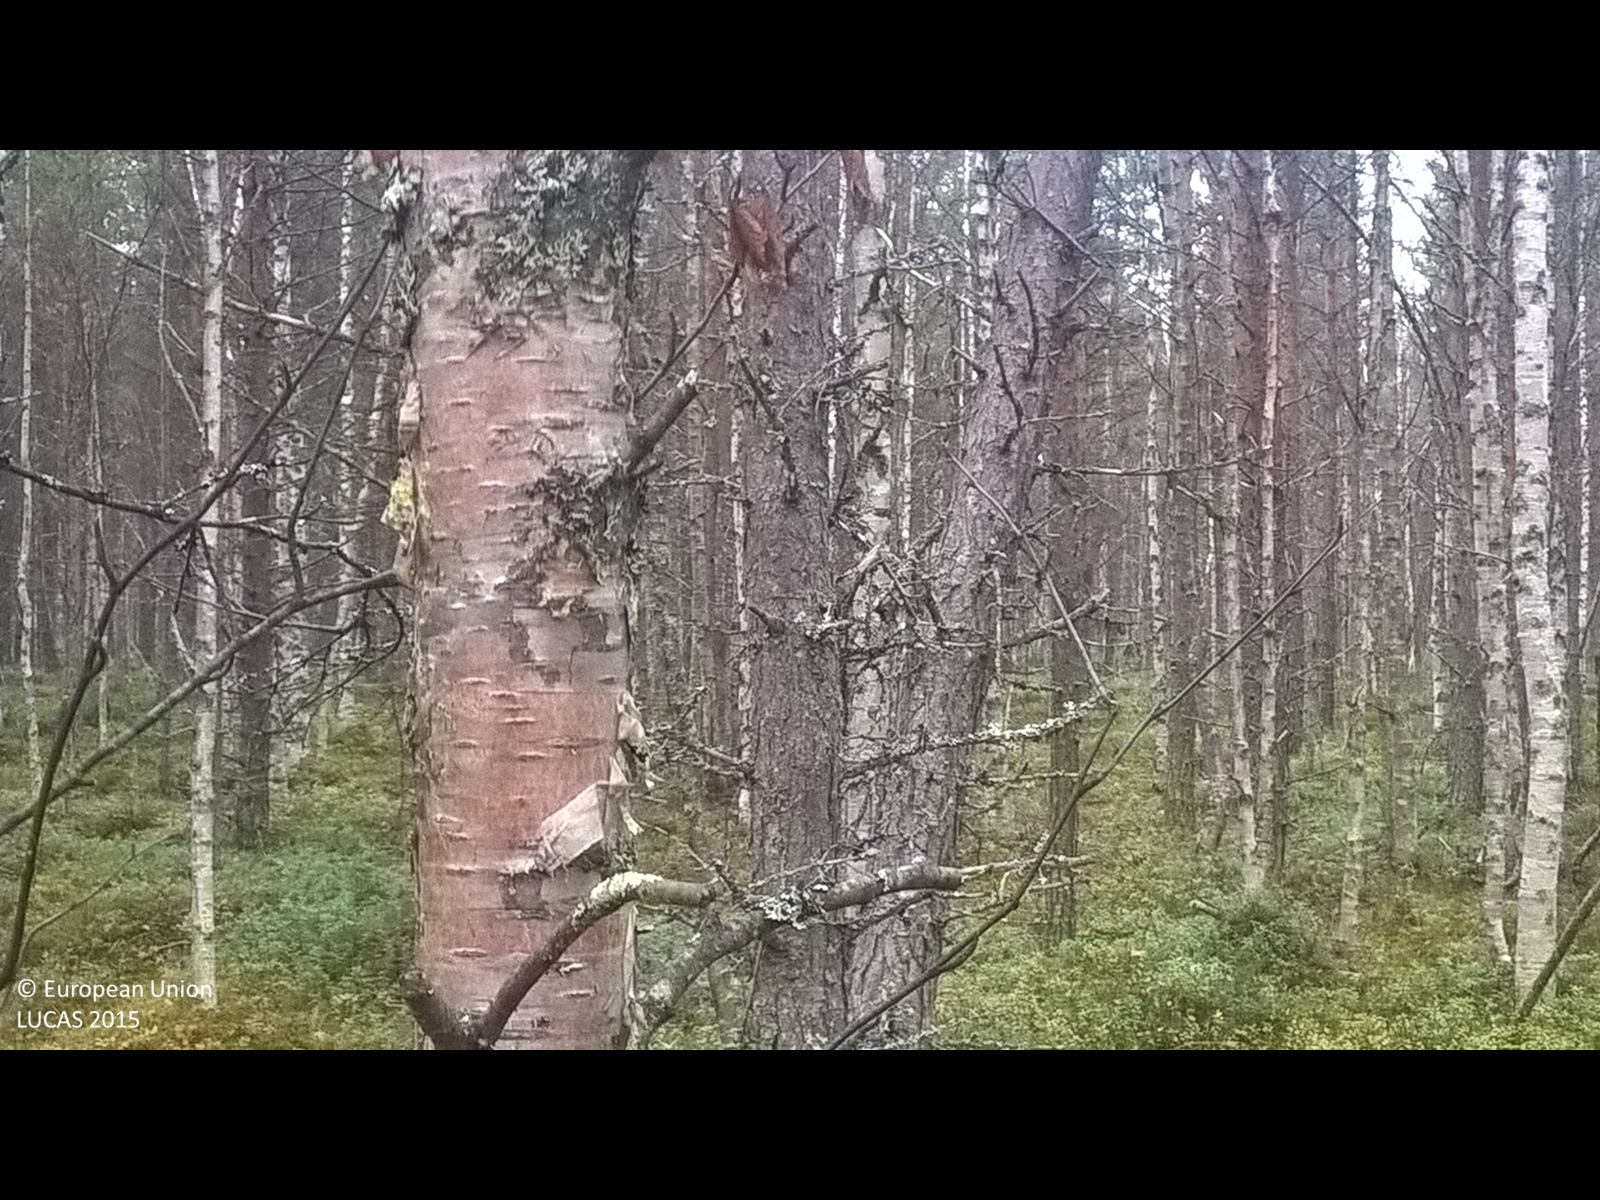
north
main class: Woodland
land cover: Pine dominated mixed woodland
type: boreal forest
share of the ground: > 75 %
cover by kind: coniferous forest trees 40 %, broadleaved forest trees 40 %, shrubs 20 %
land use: Forestry
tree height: > 5 m
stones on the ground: < 10 %
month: October
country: SE
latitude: 65.1294
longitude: 17.8685
